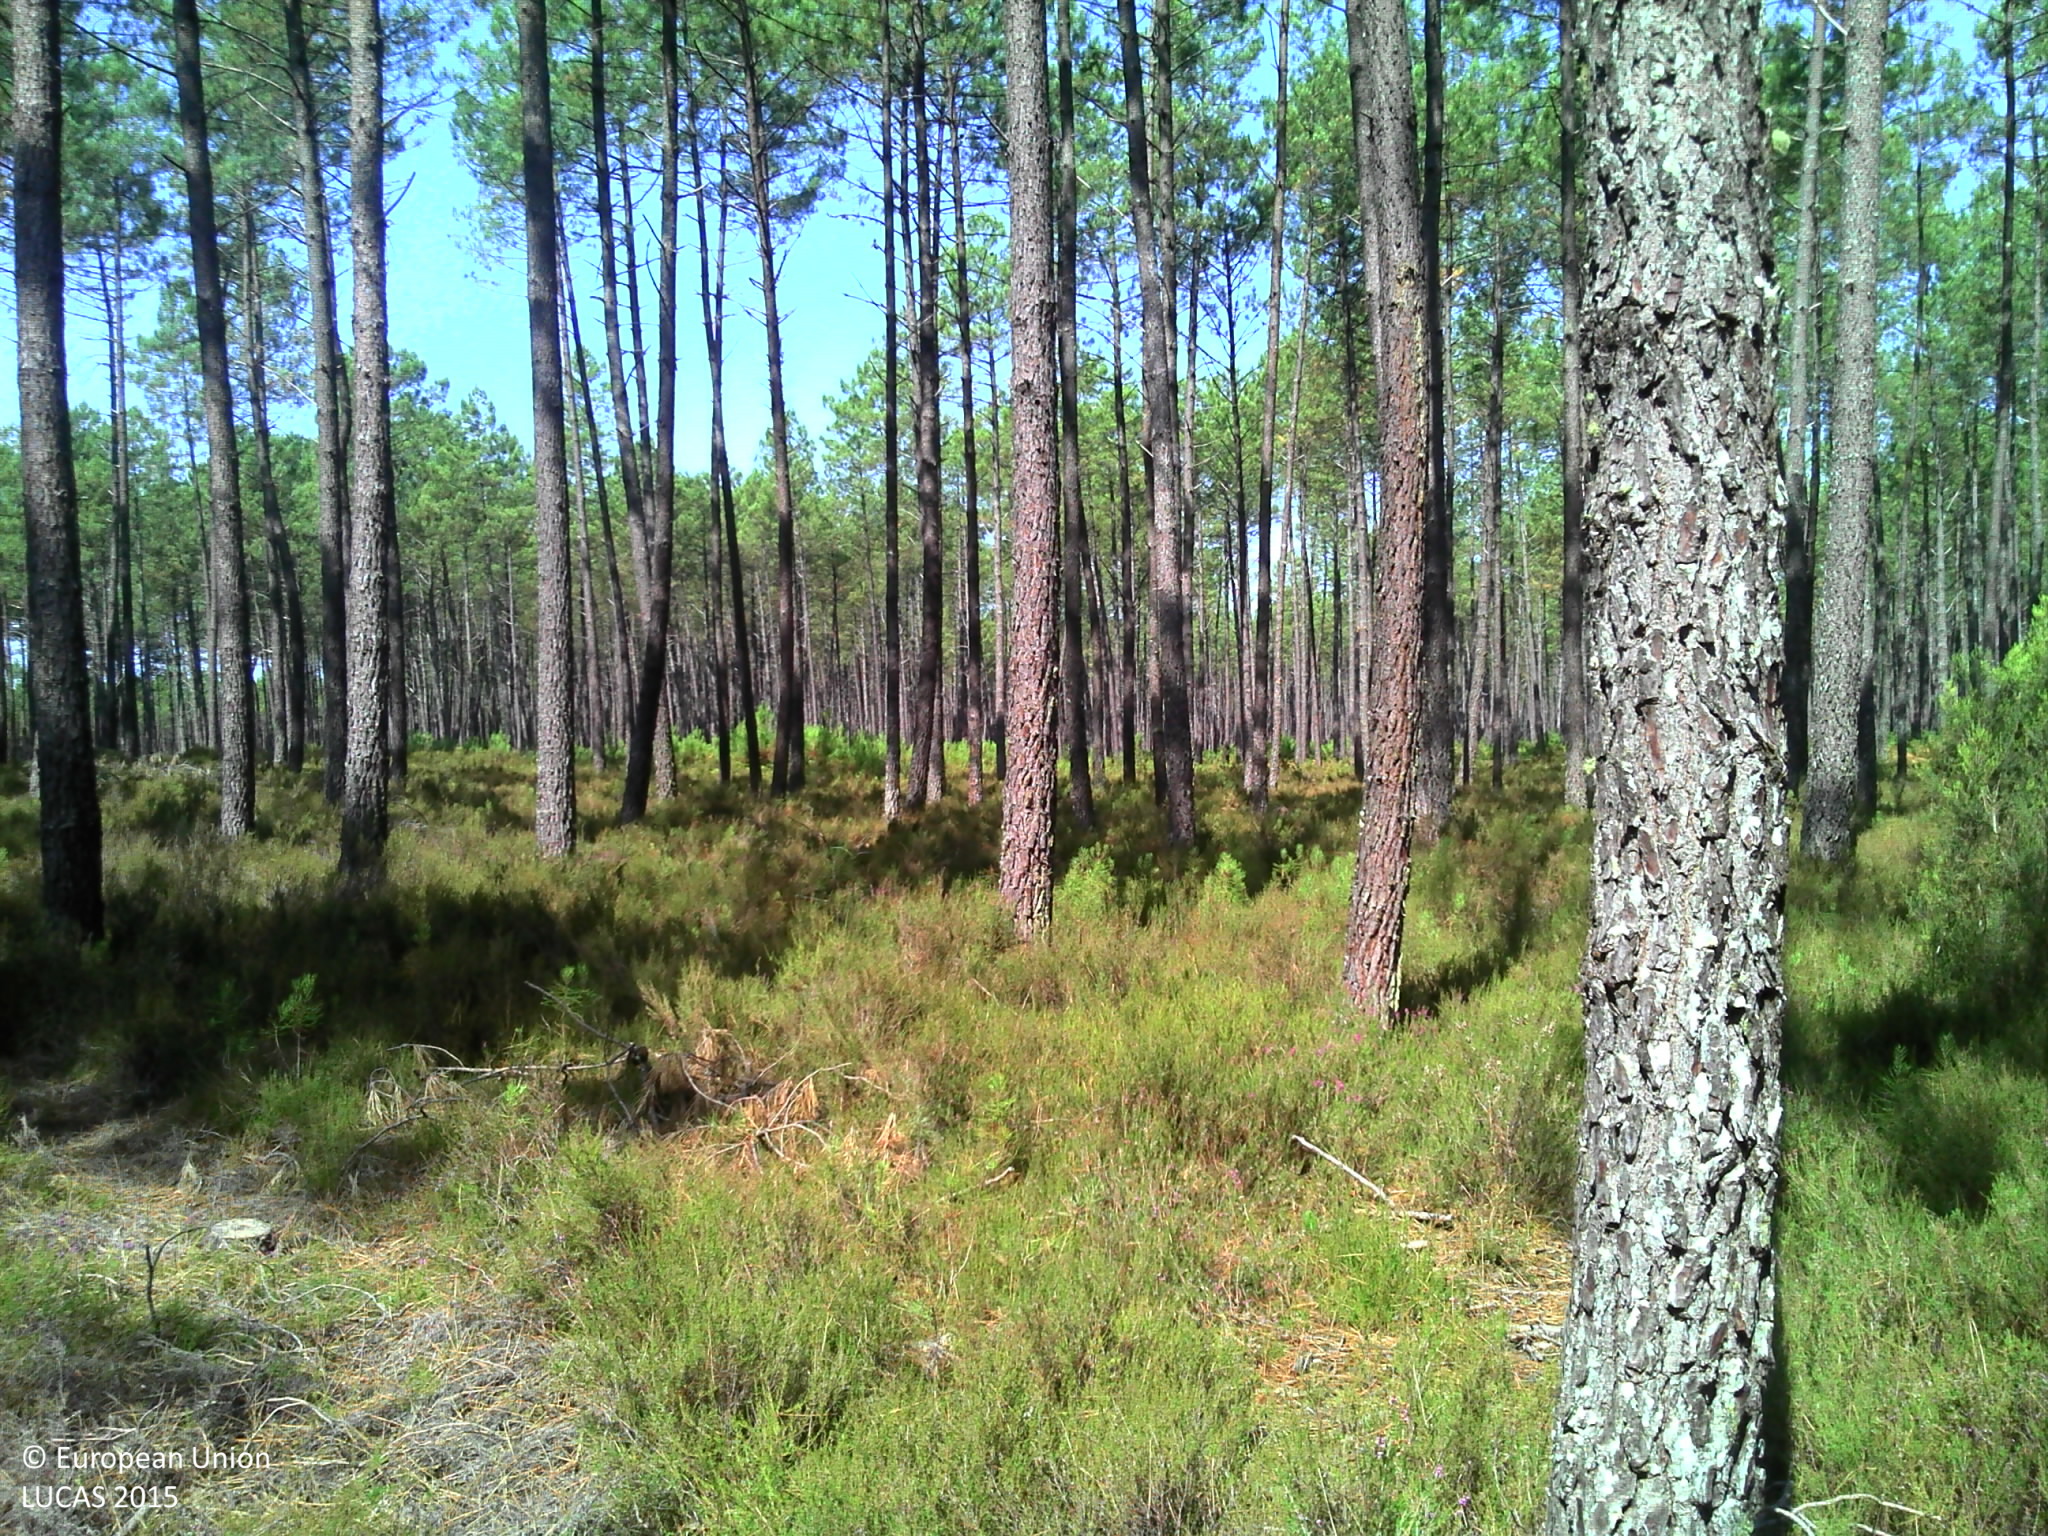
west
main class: Woodland
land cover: Pine dominated coniferous woodland
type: coniferous forest of the mediterranean region
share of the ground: > 75 %
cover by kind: coniferous forest trees 85 %, herbaceous plants 10 %, shrubs 5 %
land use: Forestry
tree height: > 5 m
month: August
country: FR
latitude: 44.1933
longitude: -1.0669
